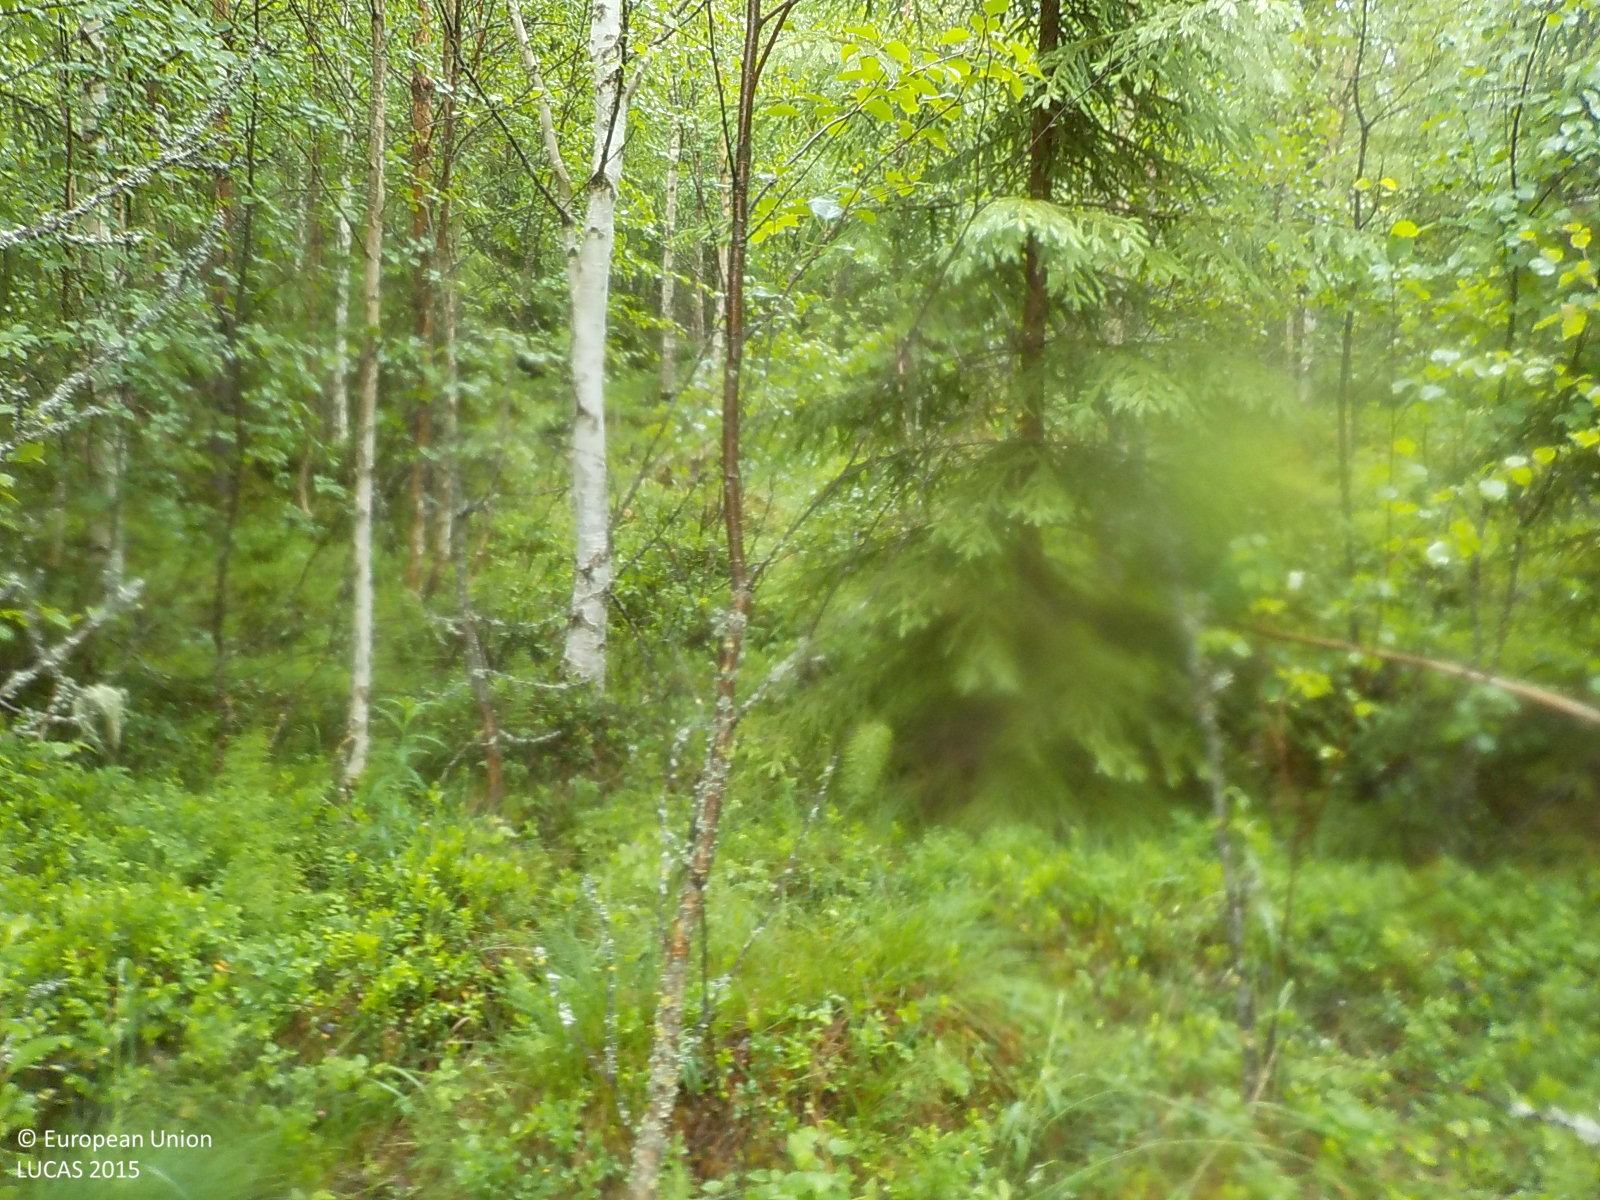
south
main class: Woodland
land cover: Broadleaved woodland
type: boreal forest
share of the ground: 50 - 75 %
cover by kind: broadleaved forest trees 60 %, herbaceous plants 30 %, lichens and mosses 10 %
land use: Forestry
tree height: > 5 m
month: July
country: SE
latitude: 63.1012
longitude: 17.0094
